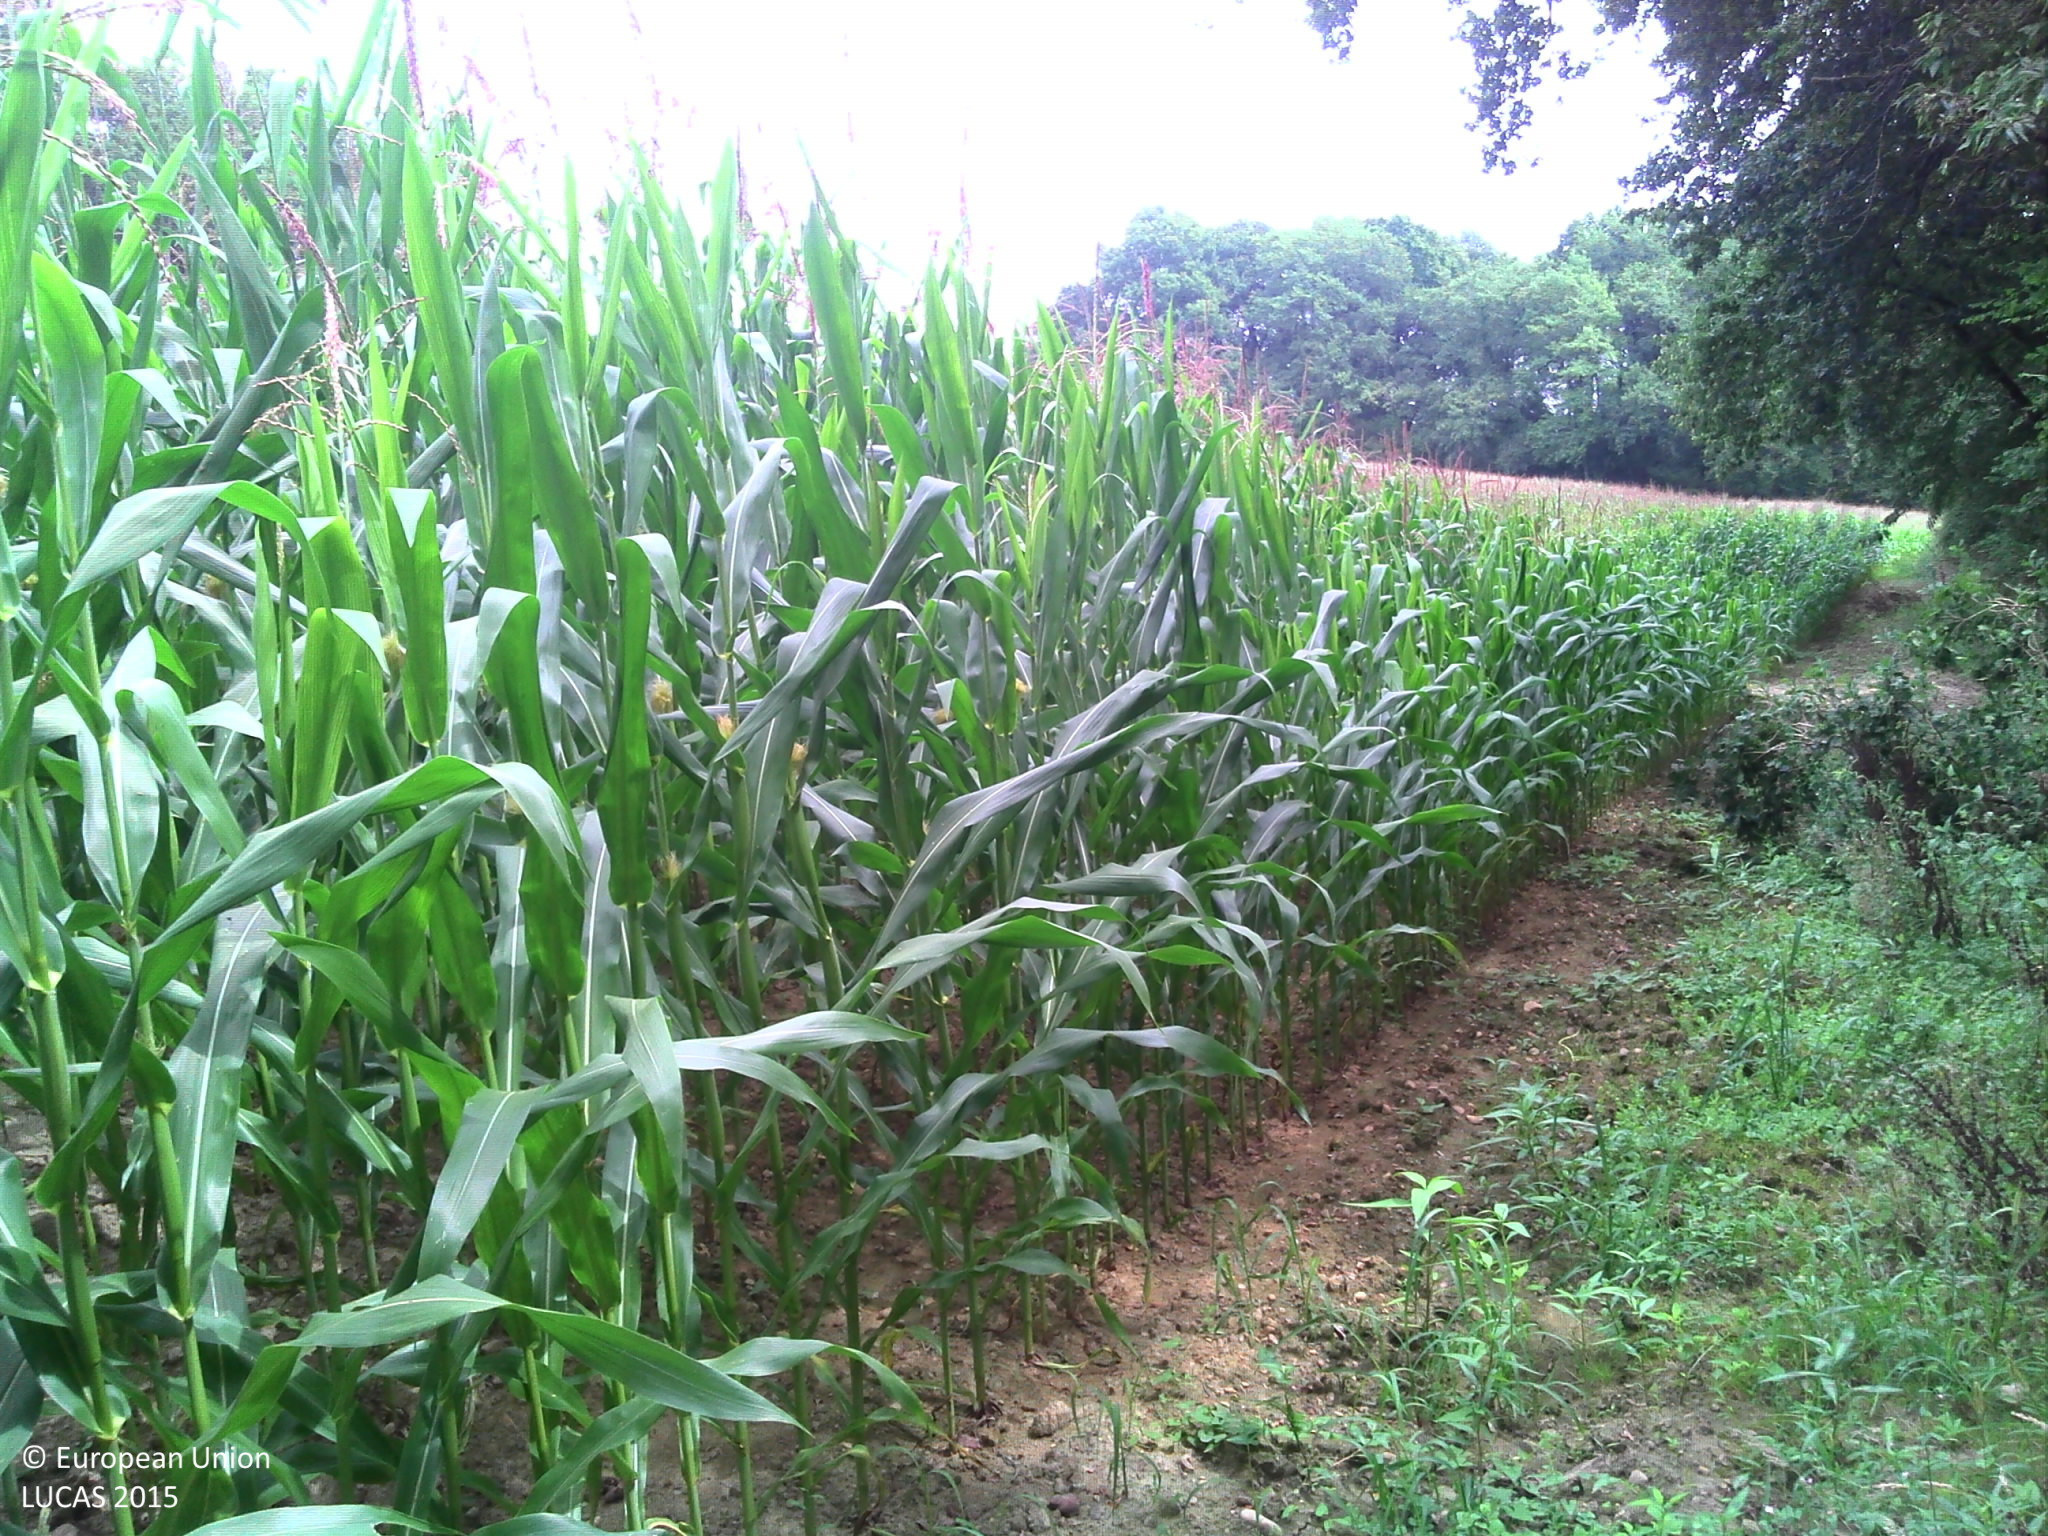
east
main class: Cropland
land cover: Maize
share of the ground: > 75 %
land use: Agriculture (excluding fallow land and kitchen gardens)
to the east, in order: Maize; Grassland without tree/shrub cover; Broadleaved woodland; Grass margins; Paved roads, cycling and walking lanes; Grass margins; Fences; Electric lines; Other structural elements; Grassland without tree/shrub cover
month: August
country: FR
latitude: 43.4824
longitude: -1.0800
